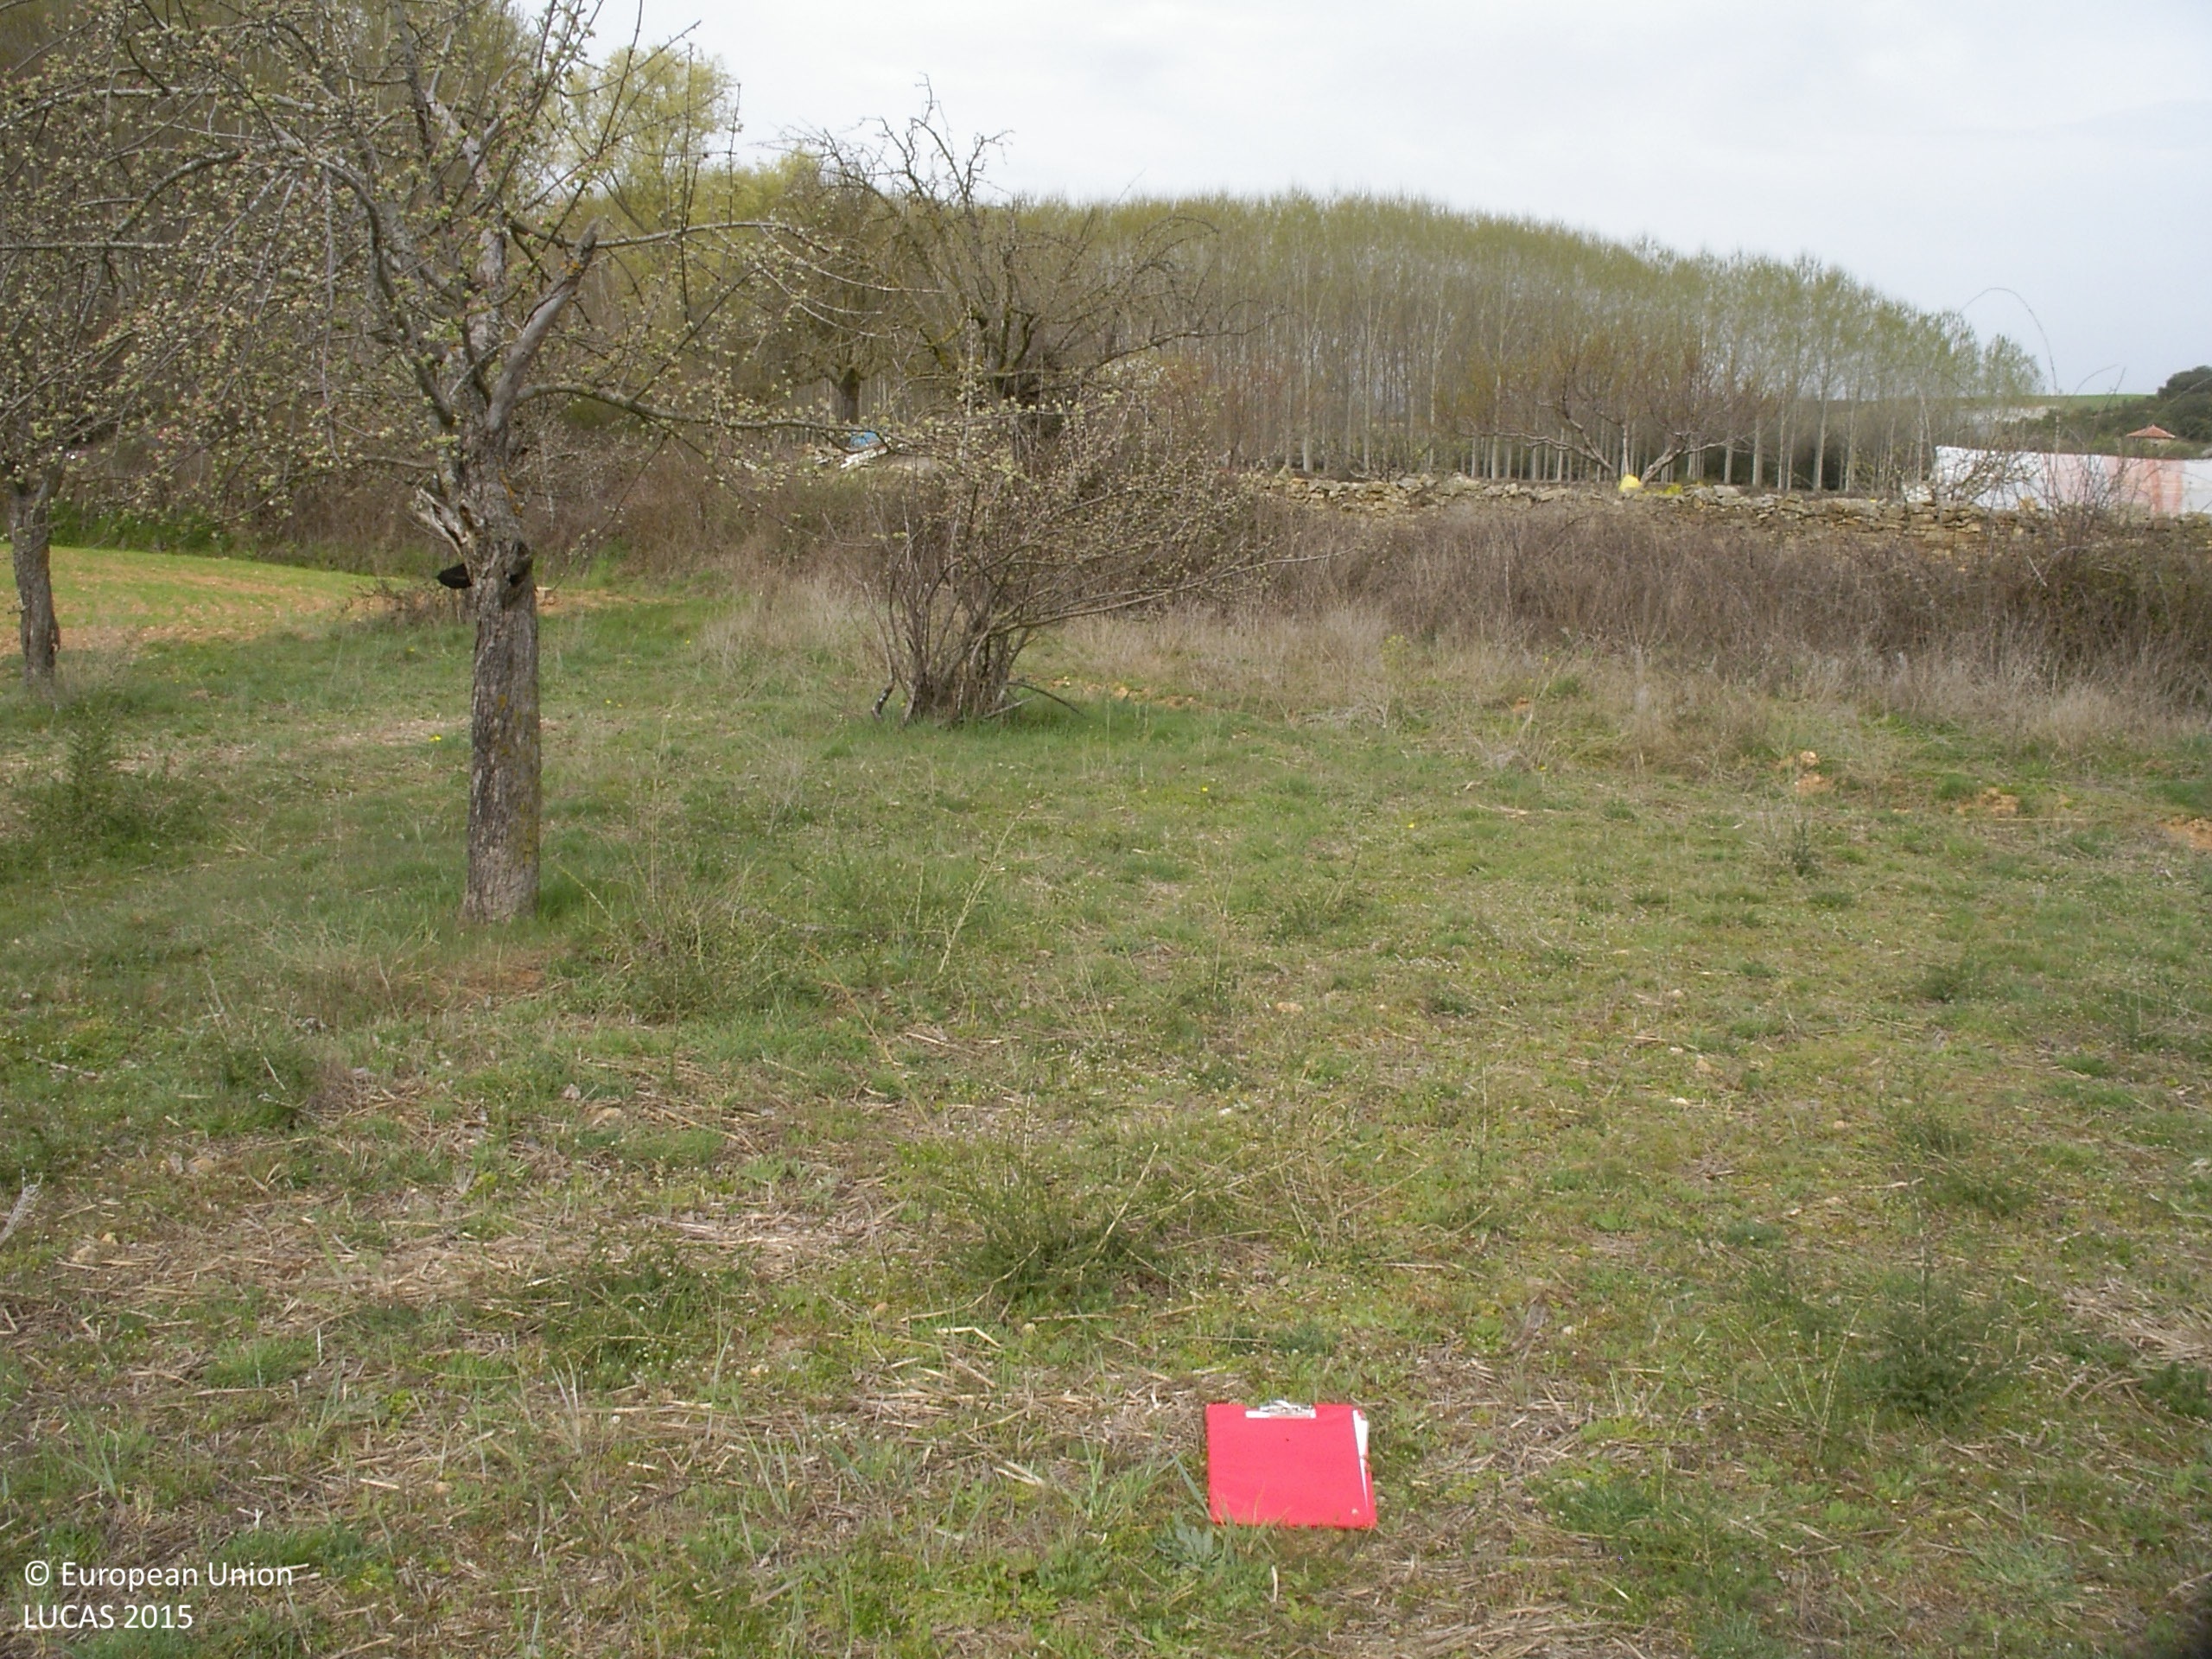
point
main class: Grassland
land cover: Grassland with sparse tree/shrub cover
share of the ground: > 75 %
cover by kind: herbaceous plants 90 %, coniferous forest trees 5 %, shrubs 5 %
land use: Agriculture (excluding fallow land and kitchen gardens)
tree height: < 5 m
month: April
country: ES
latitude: 42.4201
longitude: -6.1122
